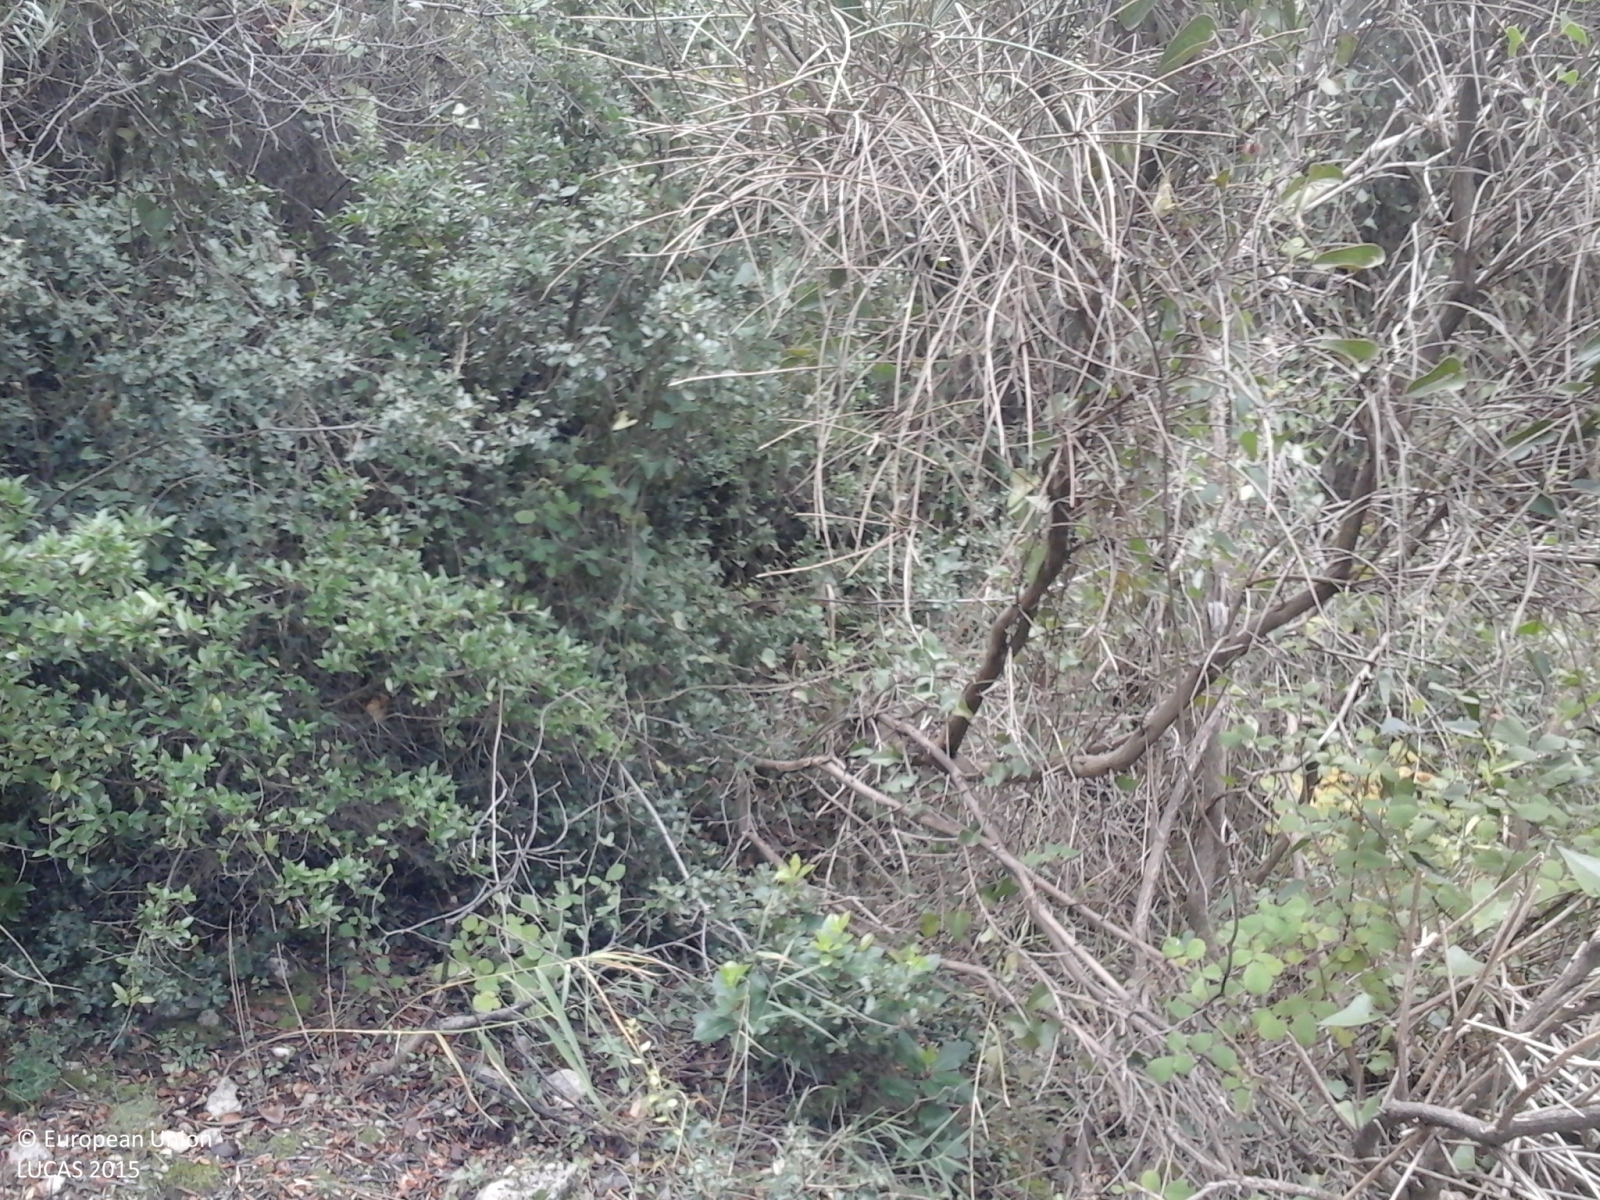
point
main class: Shrubland
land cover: Shrubland with sparse tree cover
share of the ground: > 75 %
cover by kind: shrubs 95 %, broadleaved forest trees 5 %
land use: Semi-natural and natural areas not in use
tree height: > 5 m
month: October
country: GR
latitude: 38.3651
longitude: 22.9223
